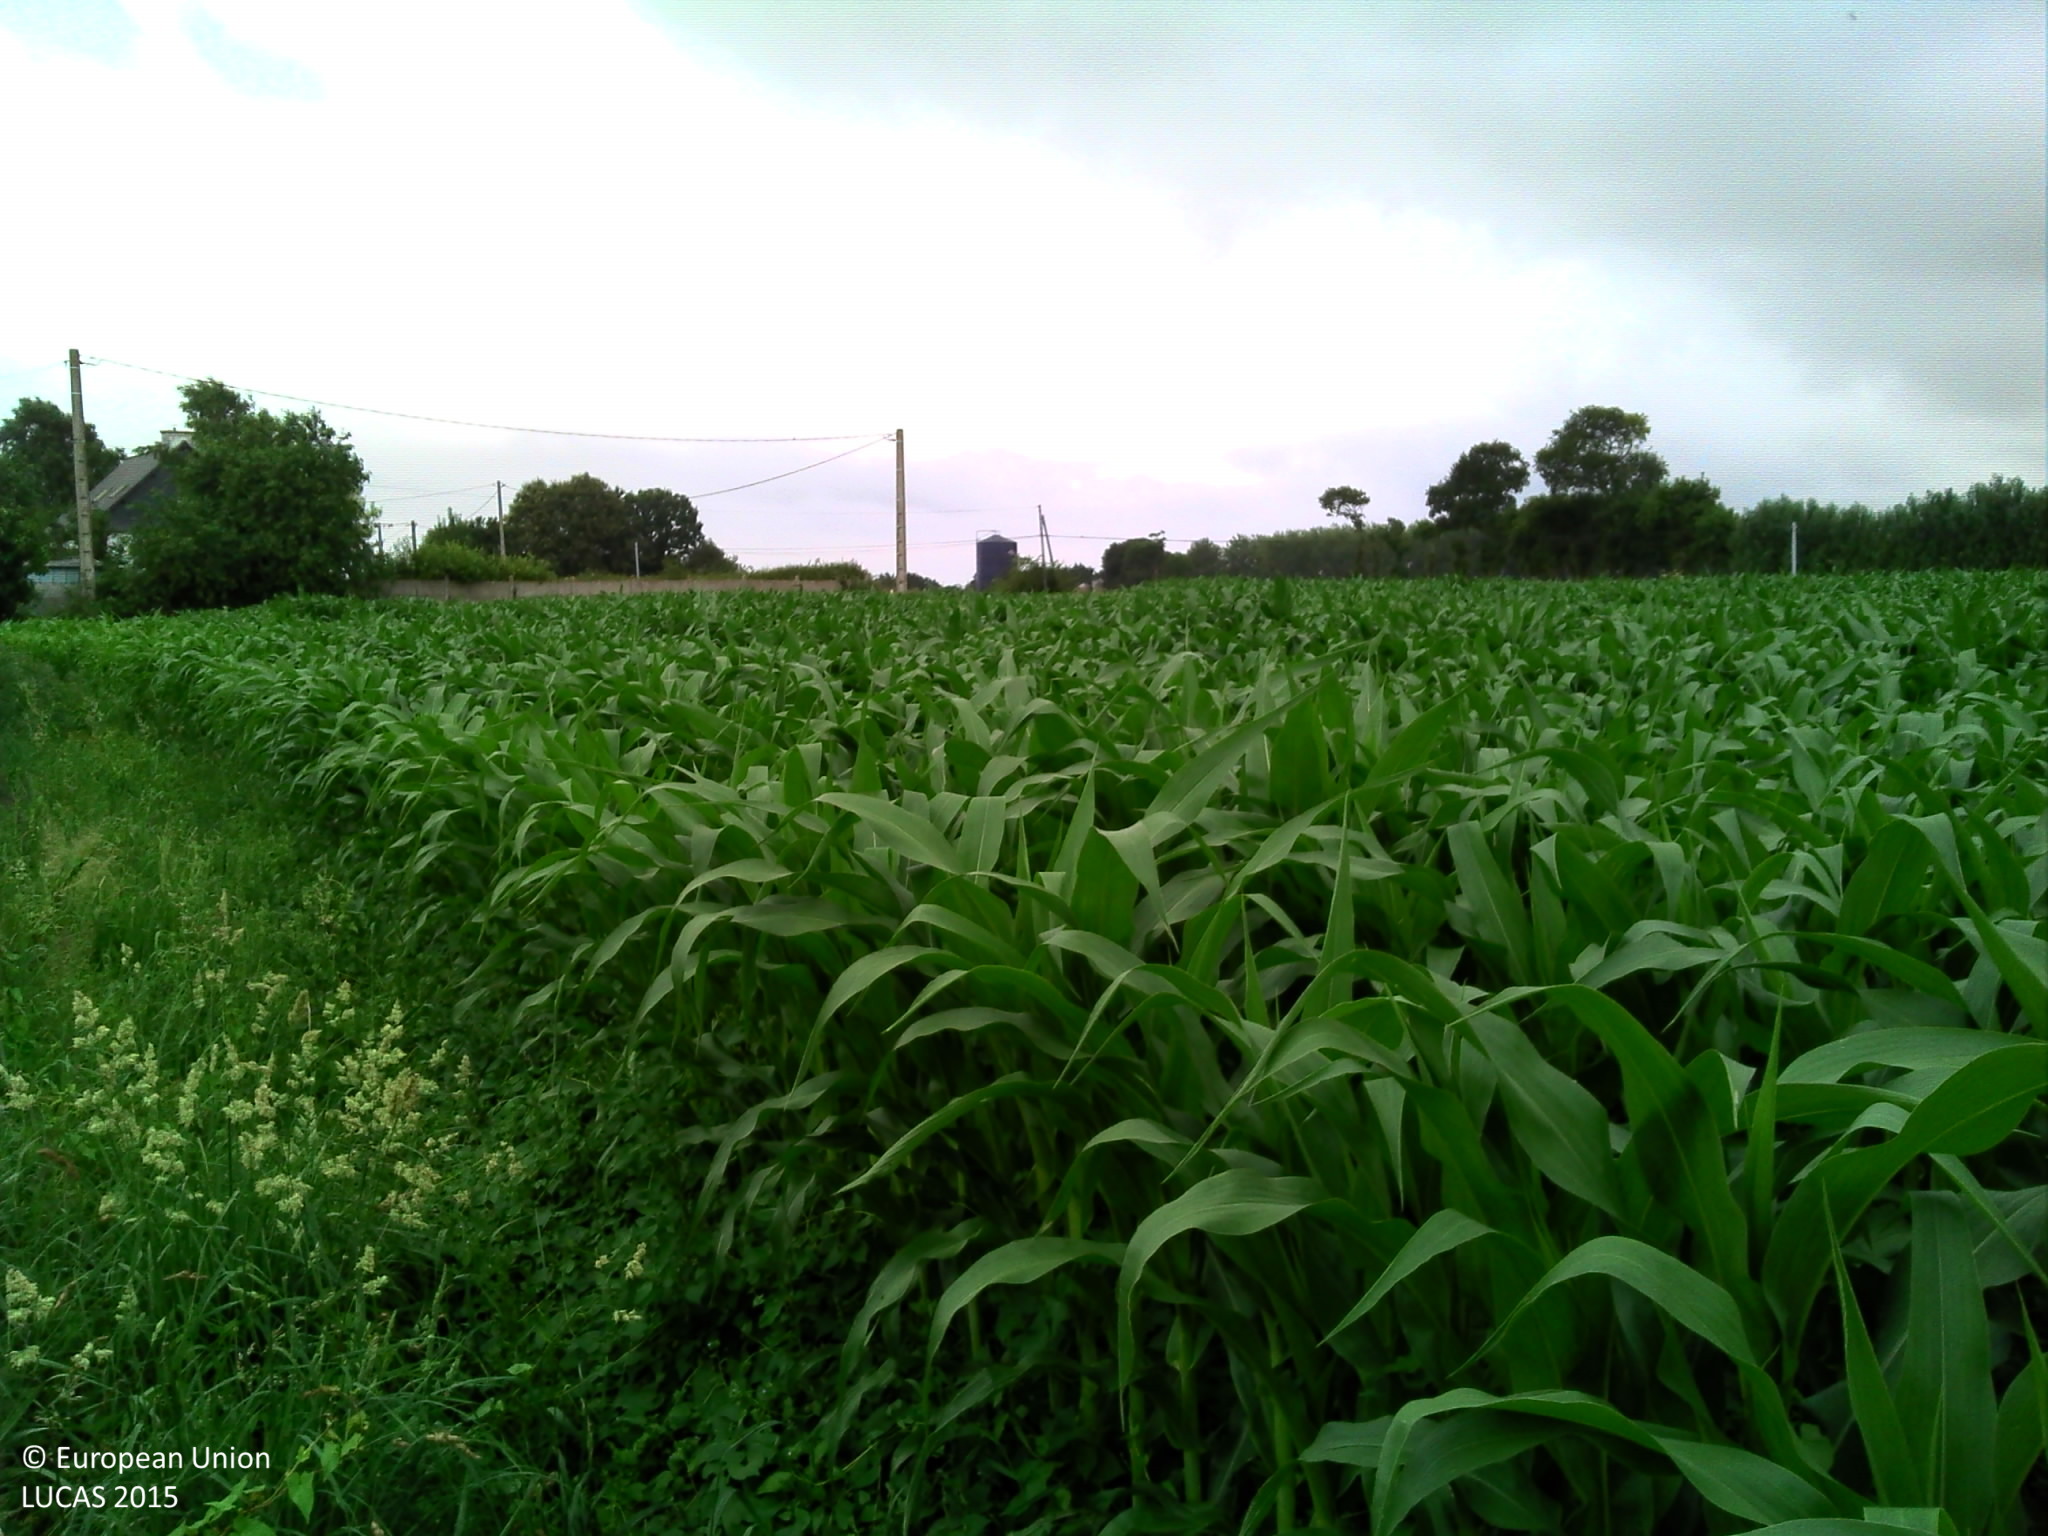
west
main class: Grassland
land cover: Grassland without tree/shrub cover
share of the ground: > 75 %
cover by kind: herbaceous plants 80 %, lichens and mosses 10 %, unconsolidated bare surface 10 %
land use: Agriculture (excluding fallow land and kitchen gardens)
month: July
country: FR
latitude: 48.5871
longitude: -2.3008
